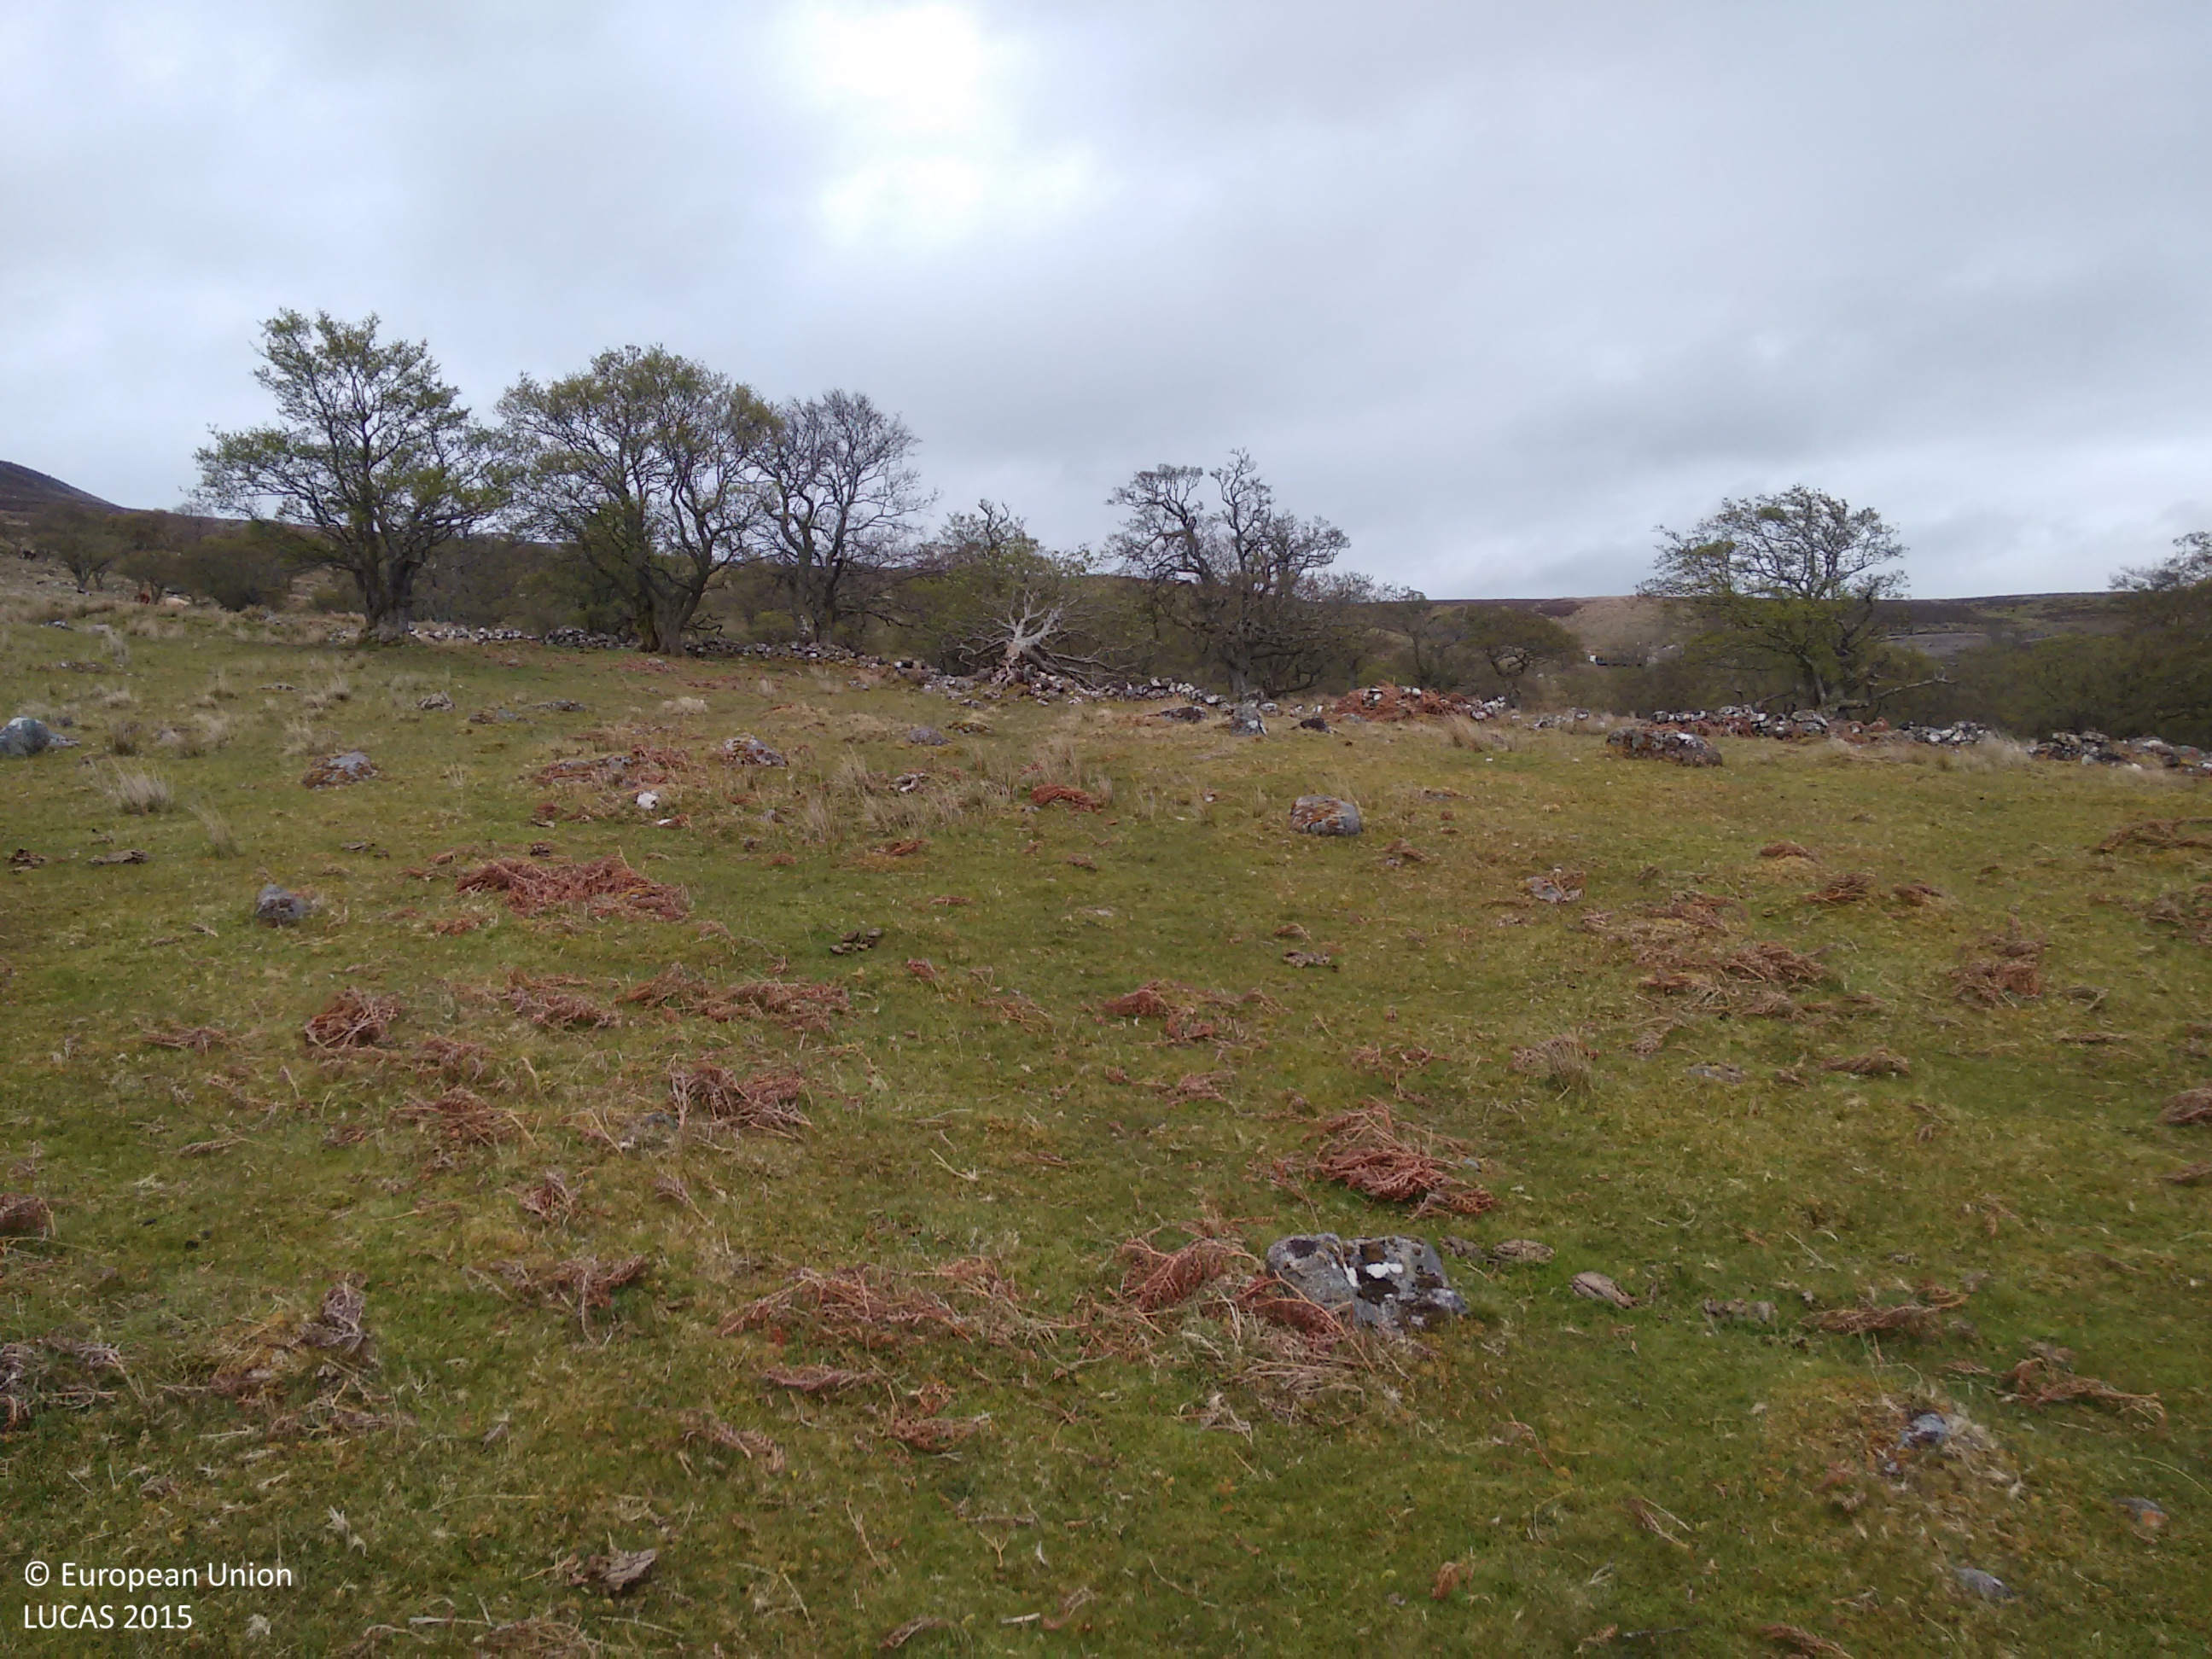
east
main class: Grassland
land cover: Grassland with sparse tree/shrub cover
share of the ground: > 75 %
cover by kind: herbaceous plants 95 %, broadleaved forest trees 5 %
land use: Agriculture (excluding fallow land and kitchen gardens)
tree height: > 5 m
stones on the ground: < 10 %
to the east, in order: Grassland with sparse tree/shrub cover; Dry stone walls; Grassland with sparse tree/shrub cover; Ditches and canals; Grassland with sparse tree/shrub cover; Broadleaved woodland; Ditches and canals; Broadleaved woodland; Grassland with sparse tree/shrub cover
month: June
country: GB
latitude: 57.2132
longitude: -4.4467
